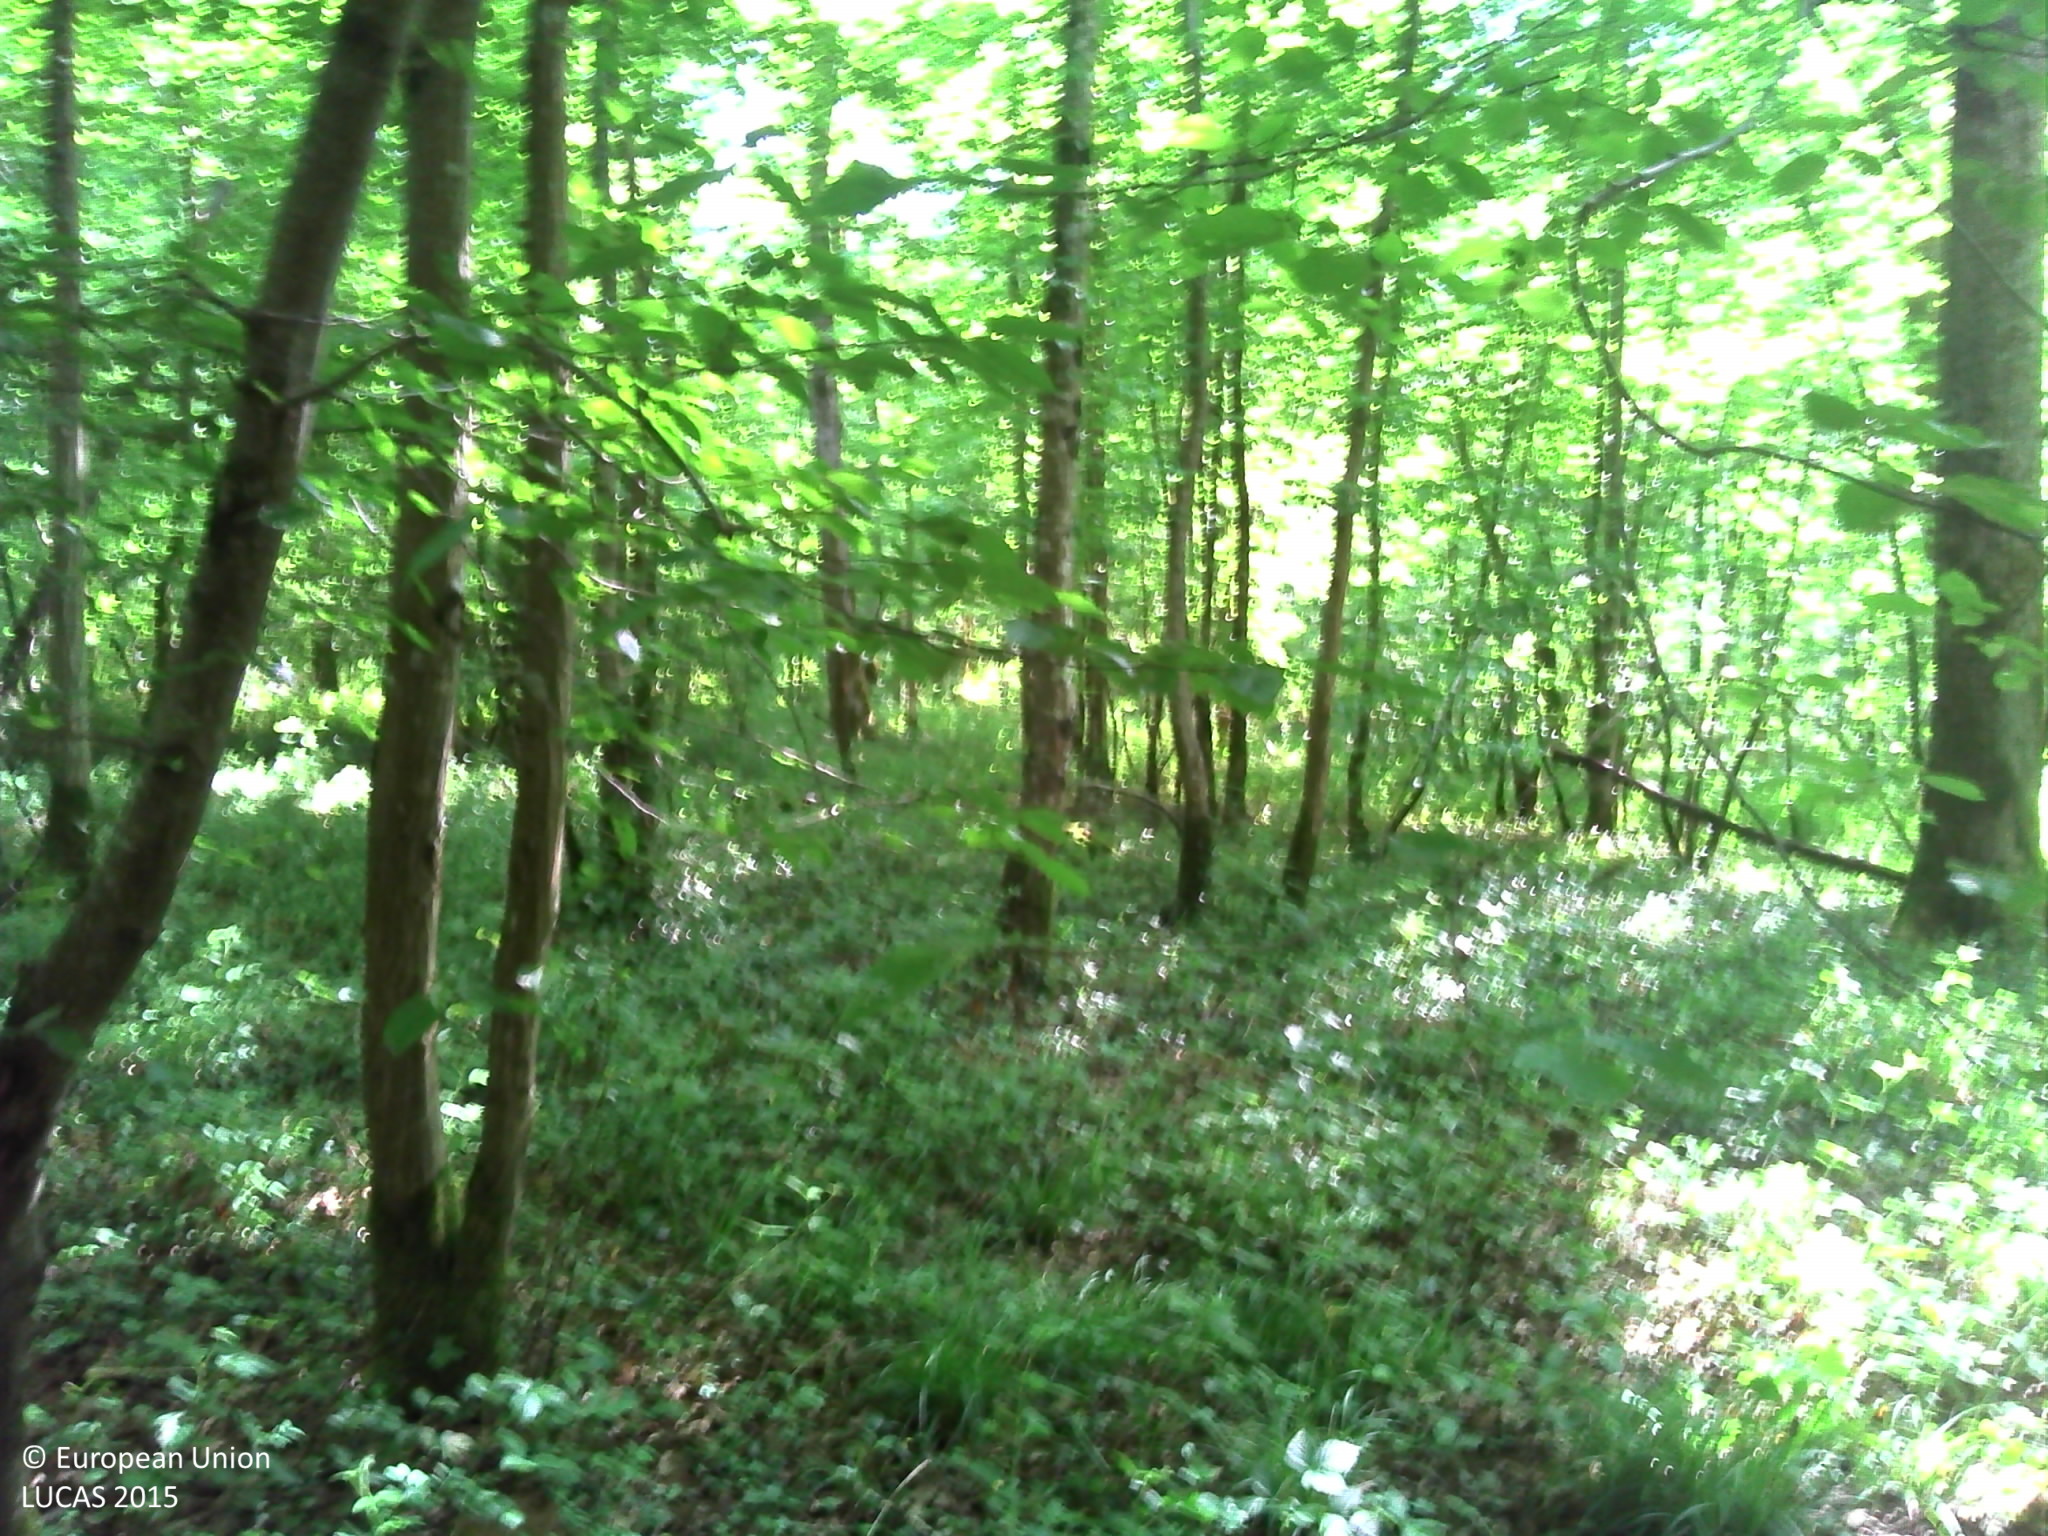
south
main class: Woodland
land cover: Broadleaved woodland
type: beech forest
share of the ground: > 75 %
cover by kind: broadleaved forest trees 95 %, herbaceous plants 5 %
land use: Forestry
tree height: > 5 m
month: June
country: FR
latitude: 47.5667
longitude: 6.2930
